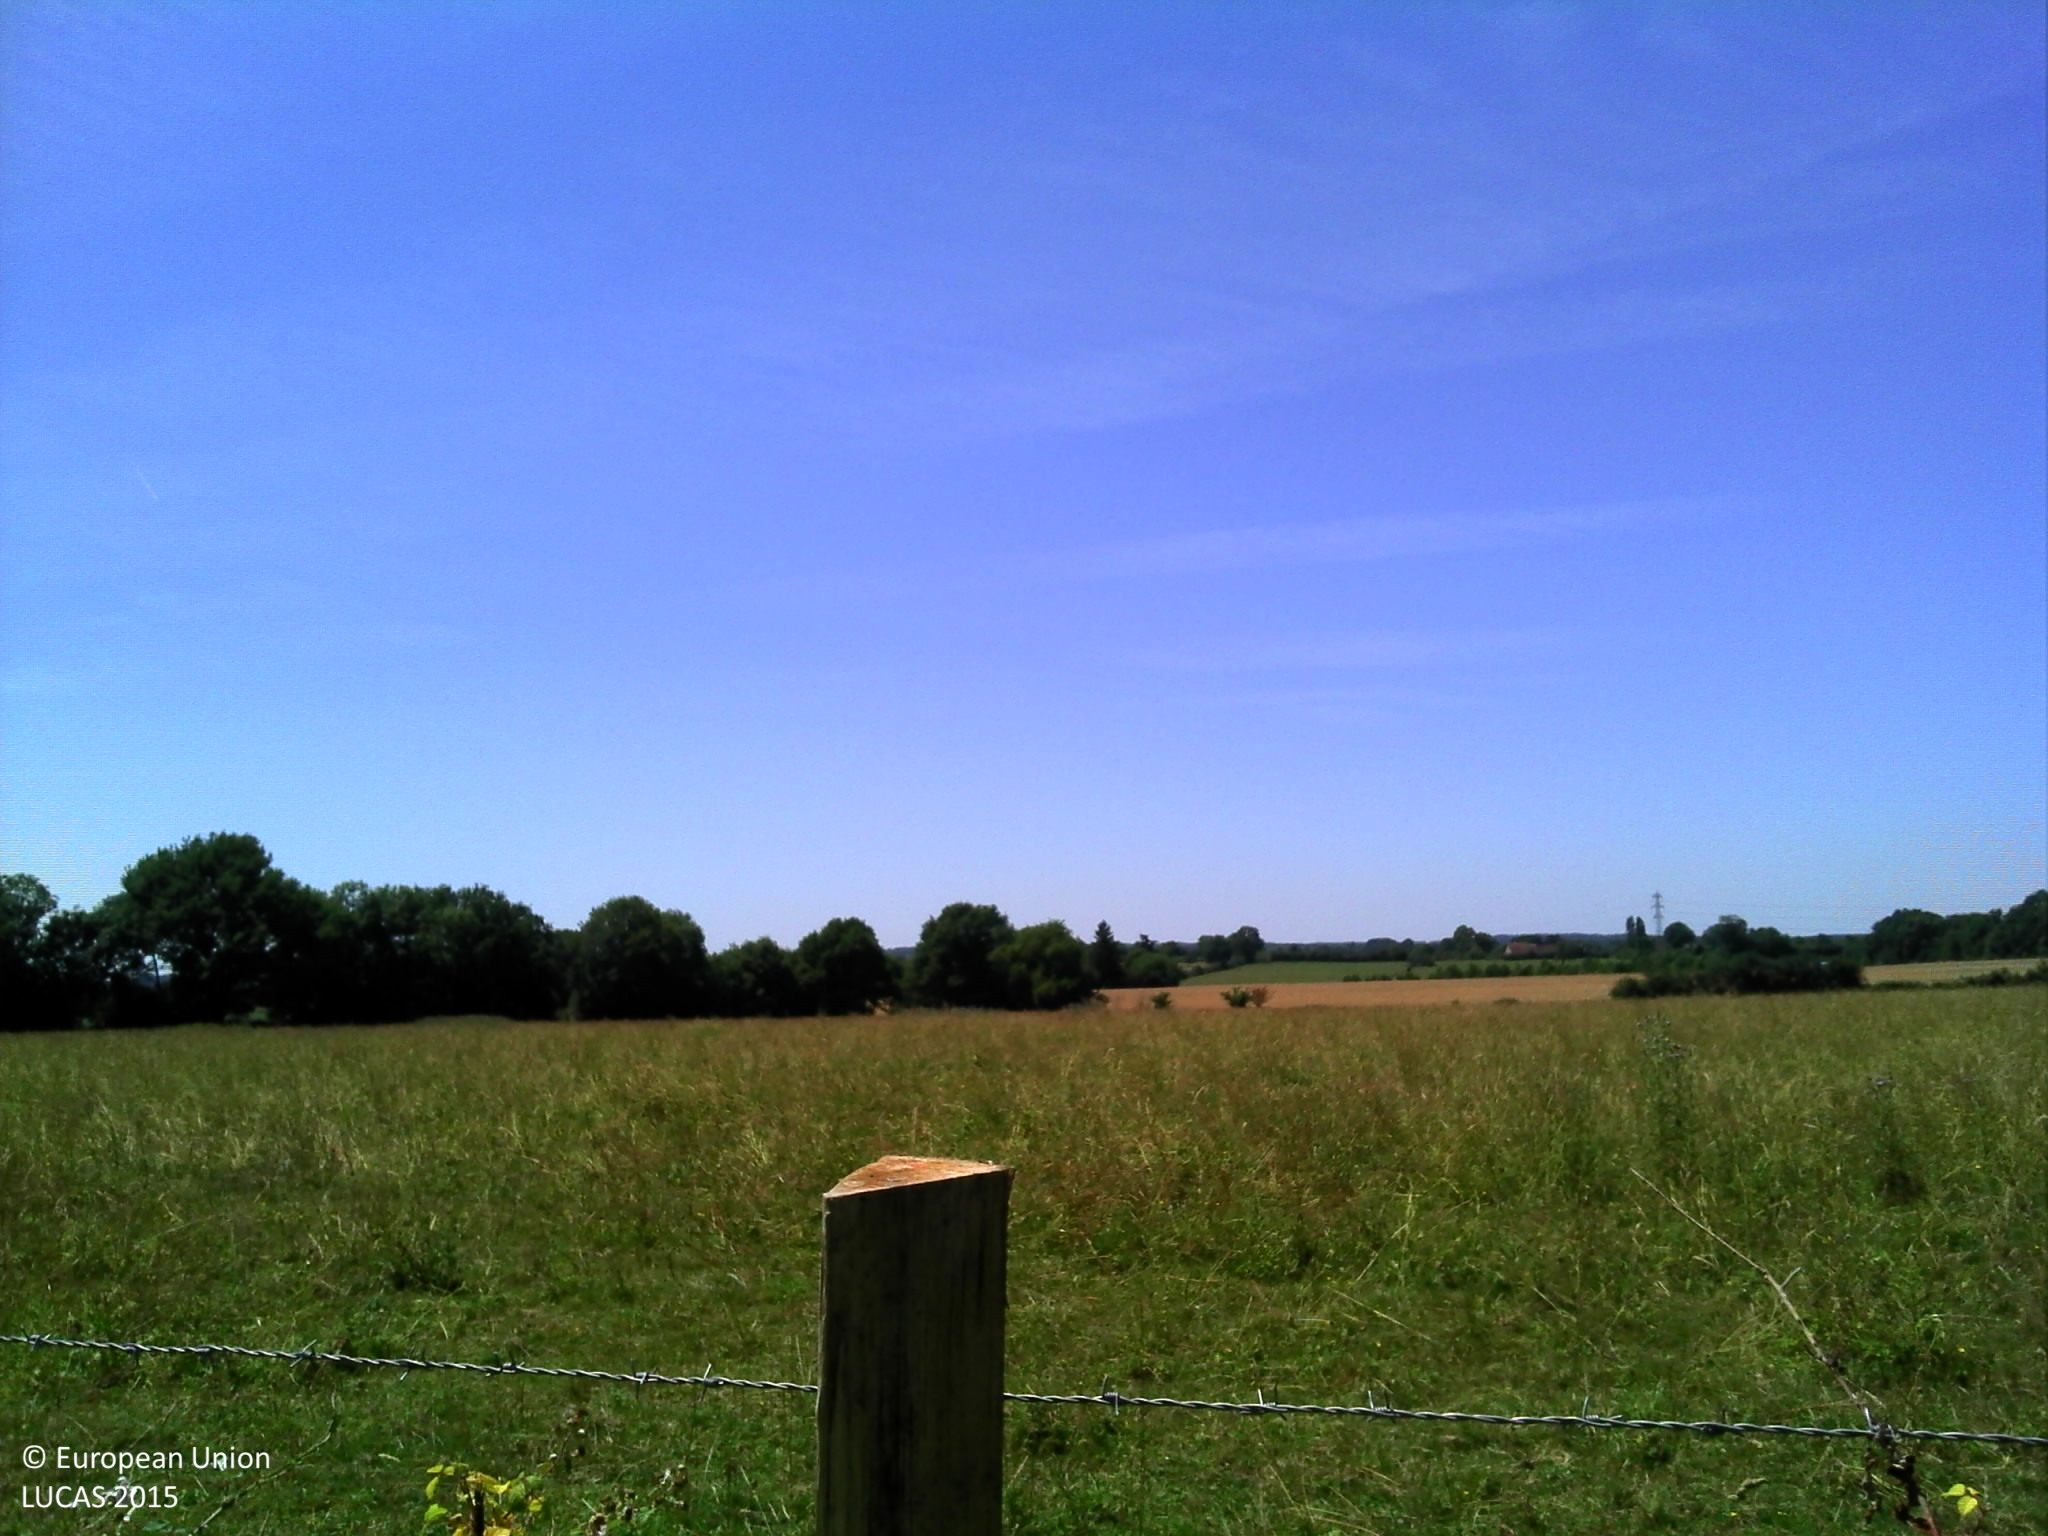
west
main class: Grassland
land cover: Grassland without tree/shrub cover
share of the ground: > 75 %
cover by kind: herbaceous plants 100 %
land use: Agriculture (excluding fallow land and kitchen gardens)
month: July
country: FR
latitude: 48.1859
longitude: 0.6289
